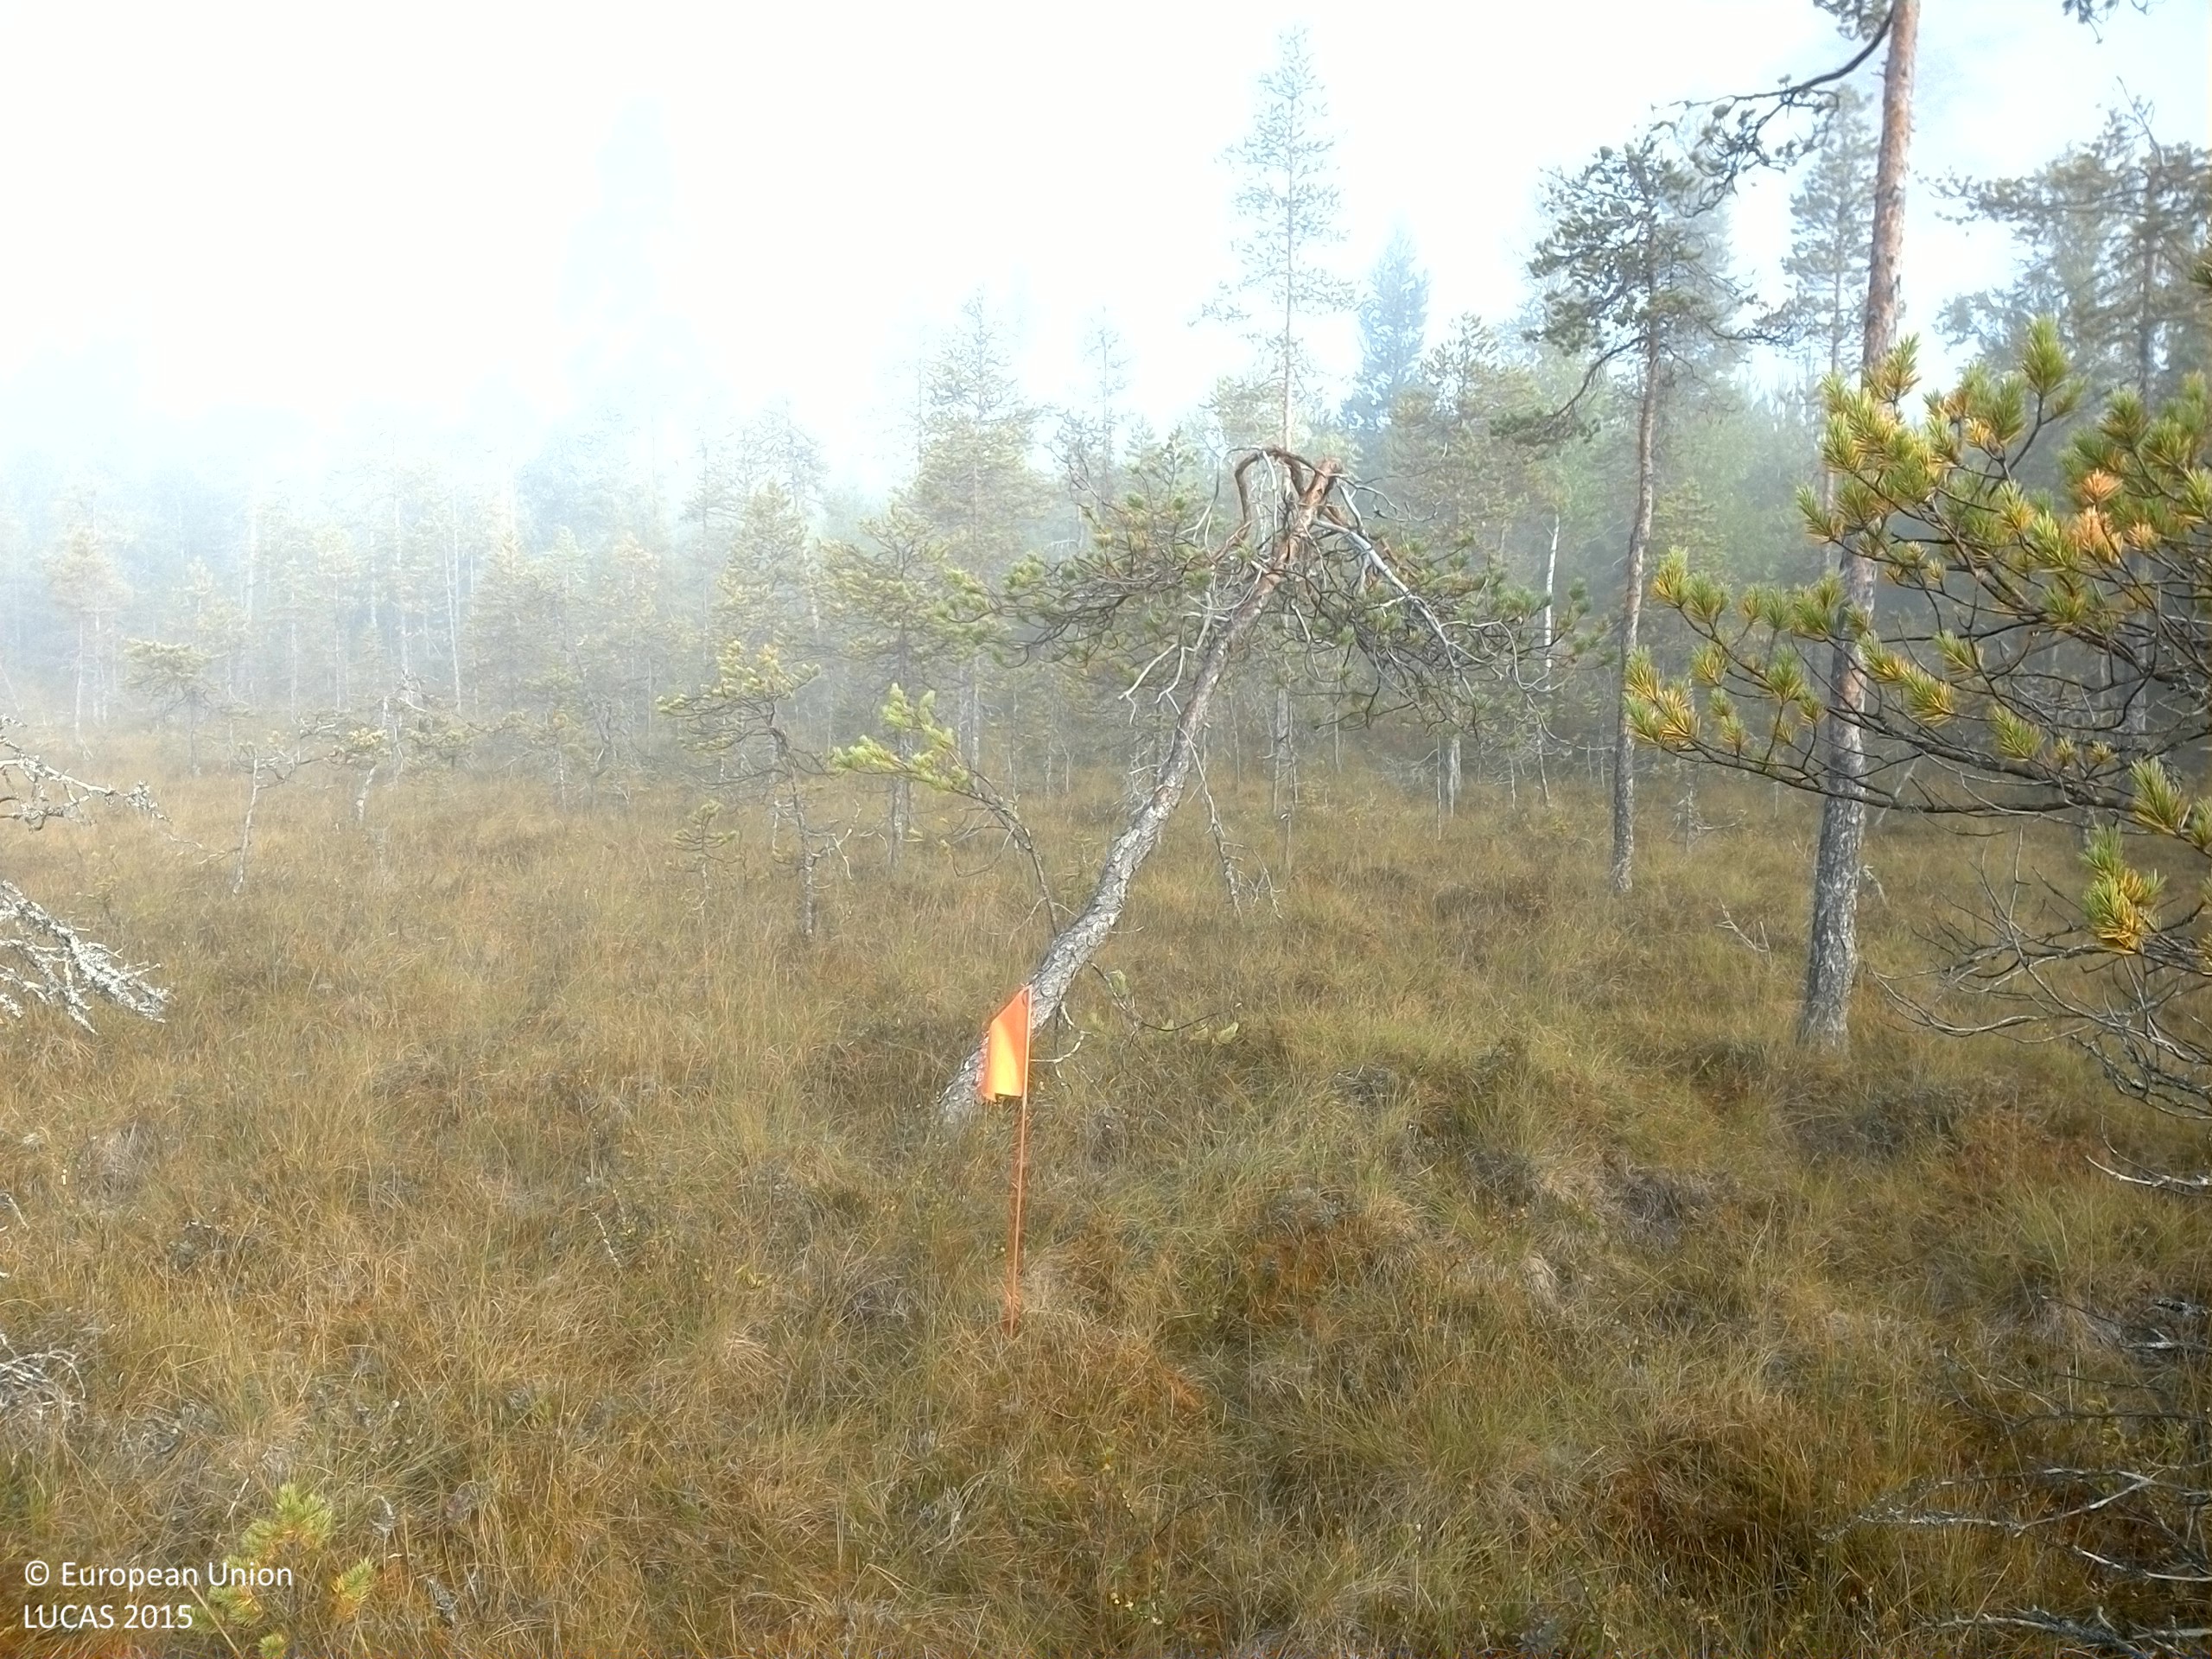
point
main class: Woodland
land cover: Pine dominated coniferous woodland
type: boreal forest
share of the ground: 10 - 25 %
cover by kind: lichens and mosses 40 %, herbaceous plants 25 %, shrubs 20 %, coniferous forest trees 15 %
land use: Semi-natural and natural areas not in use
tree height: < 5 m
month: September
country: SE
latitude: 64.0143
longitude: 17.6418
